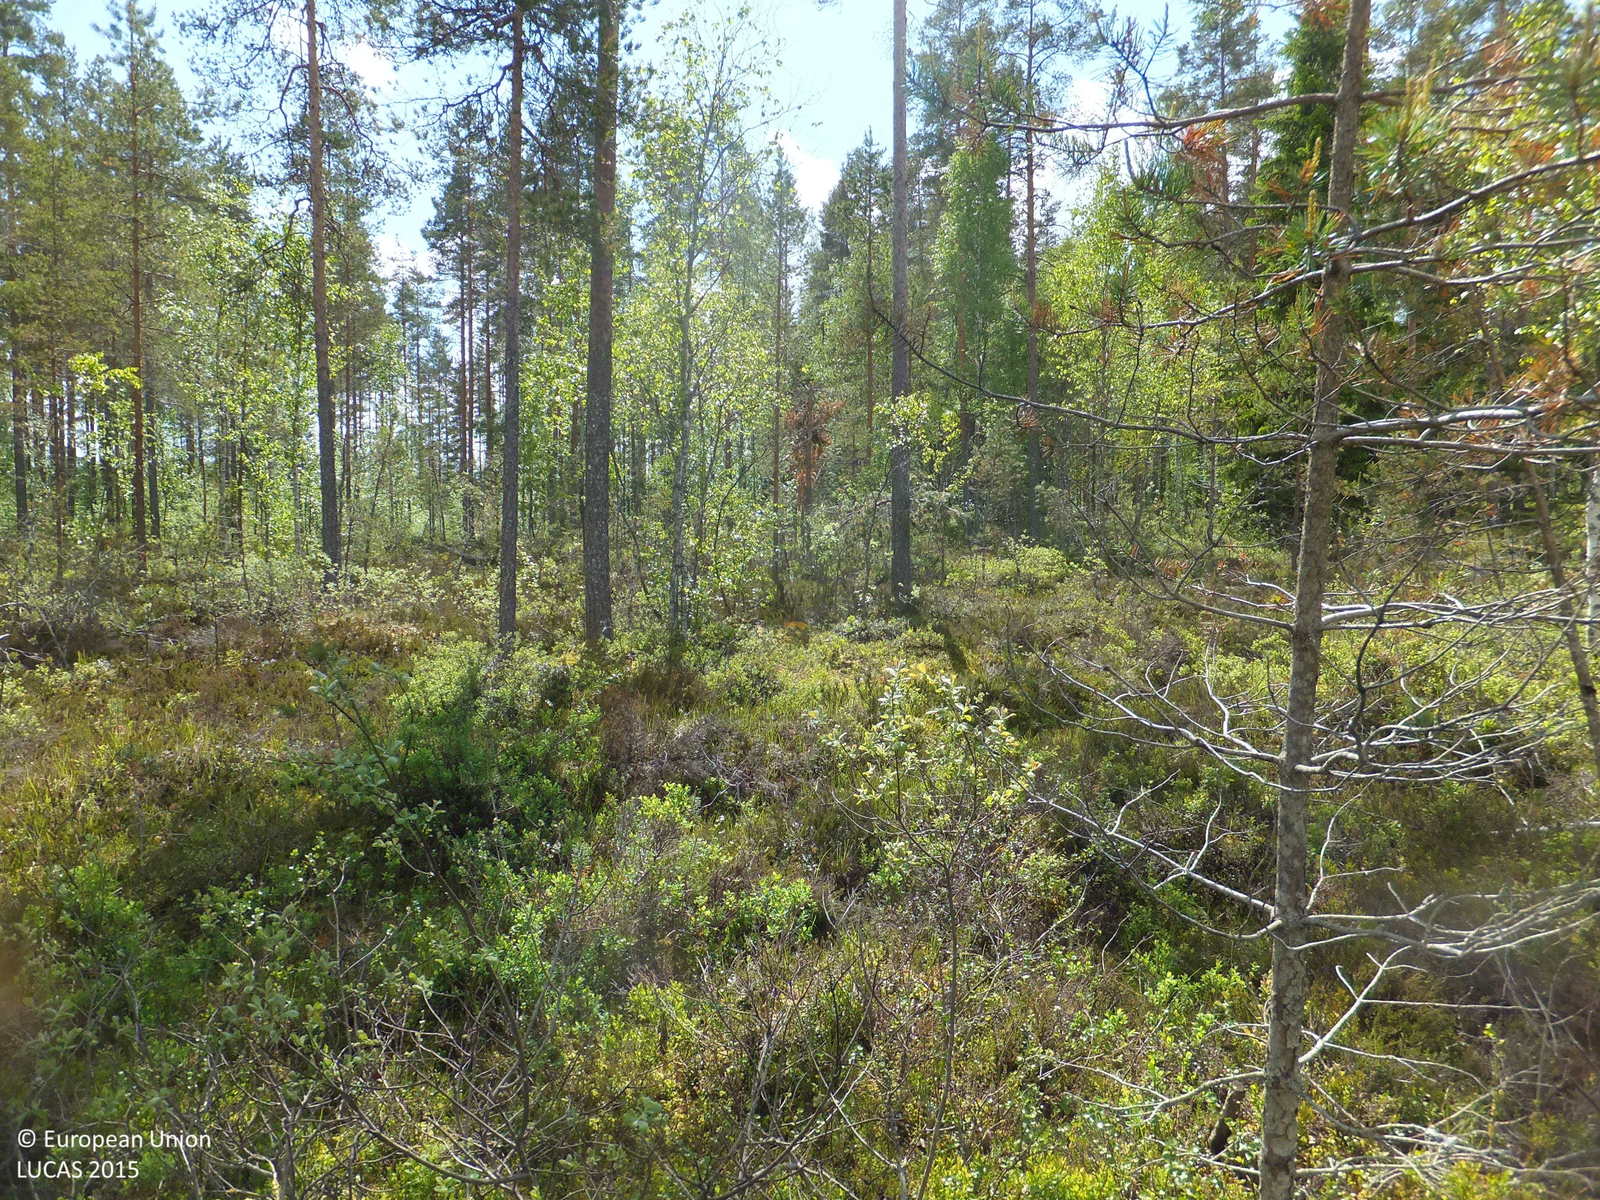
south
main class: Woodland
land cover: Pine dominated mixed woodland
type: boreal forest
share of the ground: 50 - 75 %
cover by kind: coniferous forest trees 40 %, shrubs 30 %, broadleaved forest trees 20 %, lichens and mosses 10 %
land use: Forestry
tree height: < 5 m
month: June
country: FI
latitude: 63.5585
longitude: 23.9377
